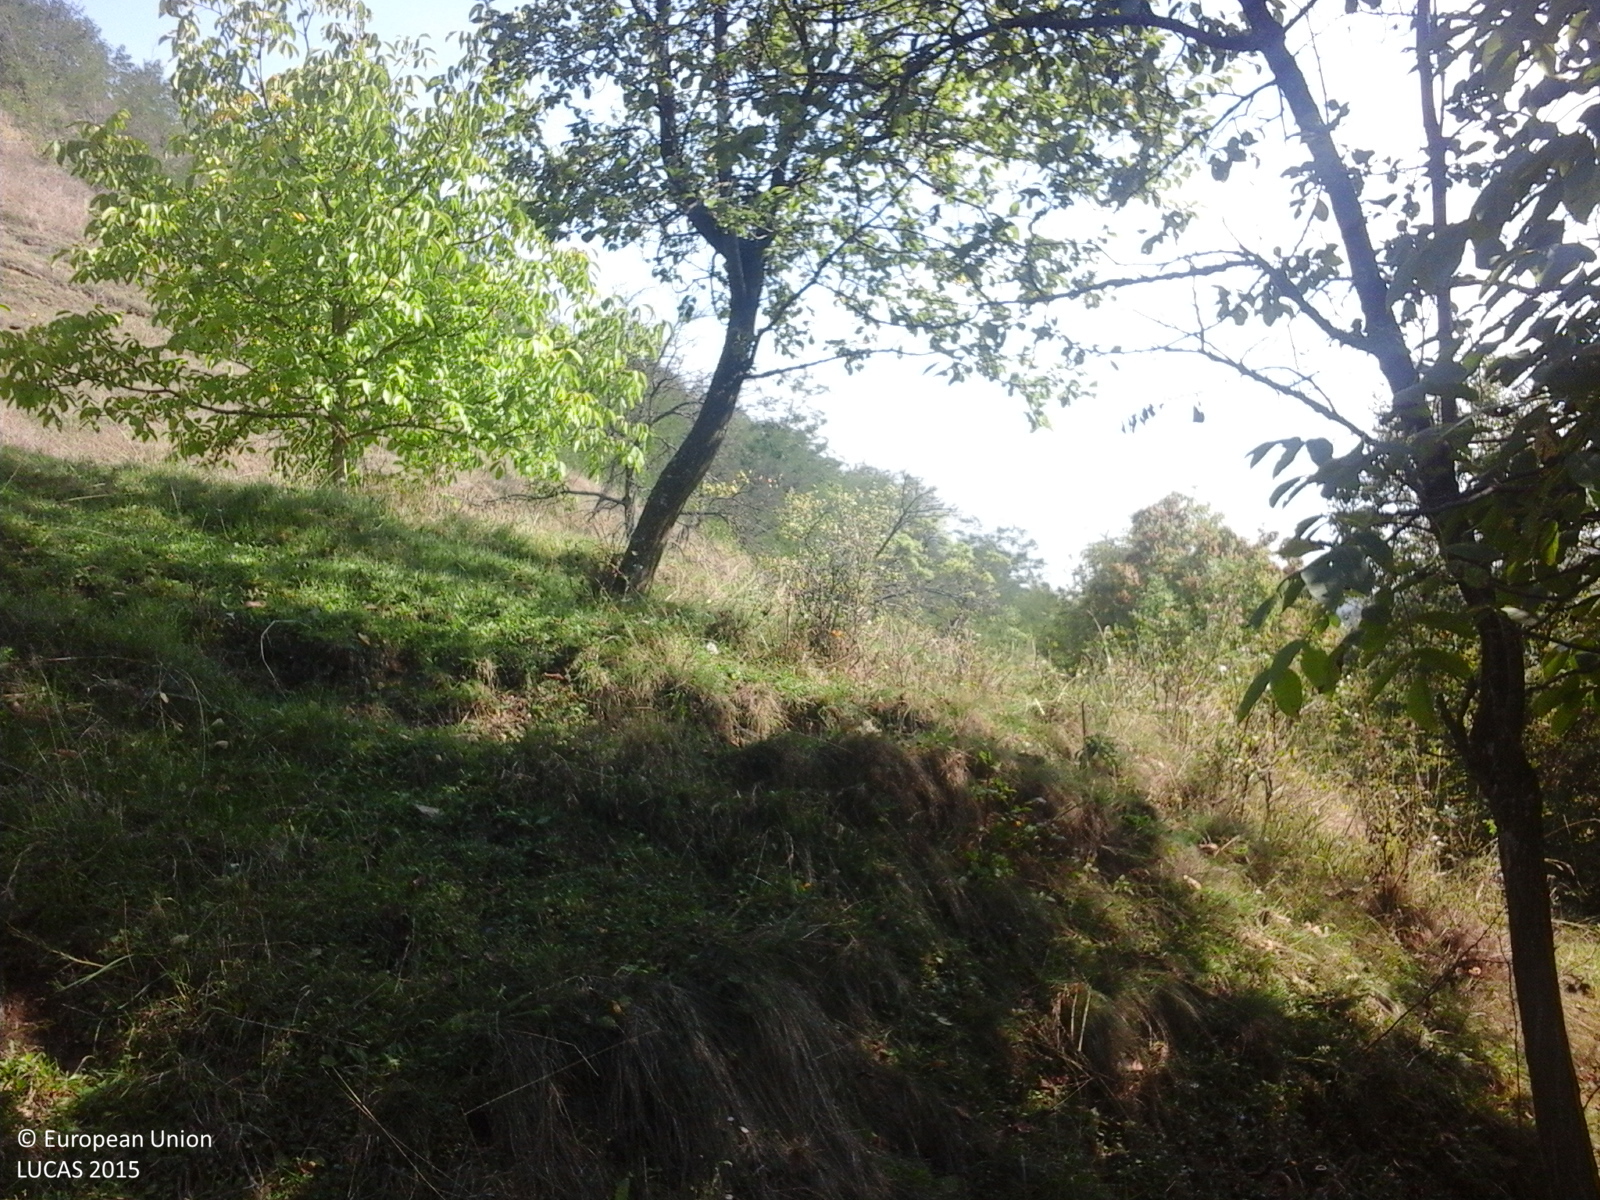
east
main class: Cropland
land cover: Other fruit trees and berries
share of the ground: > 75 %
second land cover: Grassland without tree/shrub cover
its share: > 75 %
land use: Agriculture (excluding fallow land and kitchen gardens)
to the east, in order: Other fruit trees and berries; Grassland without tree/shrub cover; Fences; Tracks; Fences; Other fruit trees and berries; Fences; Tracks; Broadleaved woodland; Fences; Grassland with sparse tree/shrub cover; Fences; Other fruit trees and berries
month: September
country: RO
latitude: 45.6052
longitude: 22.7299
